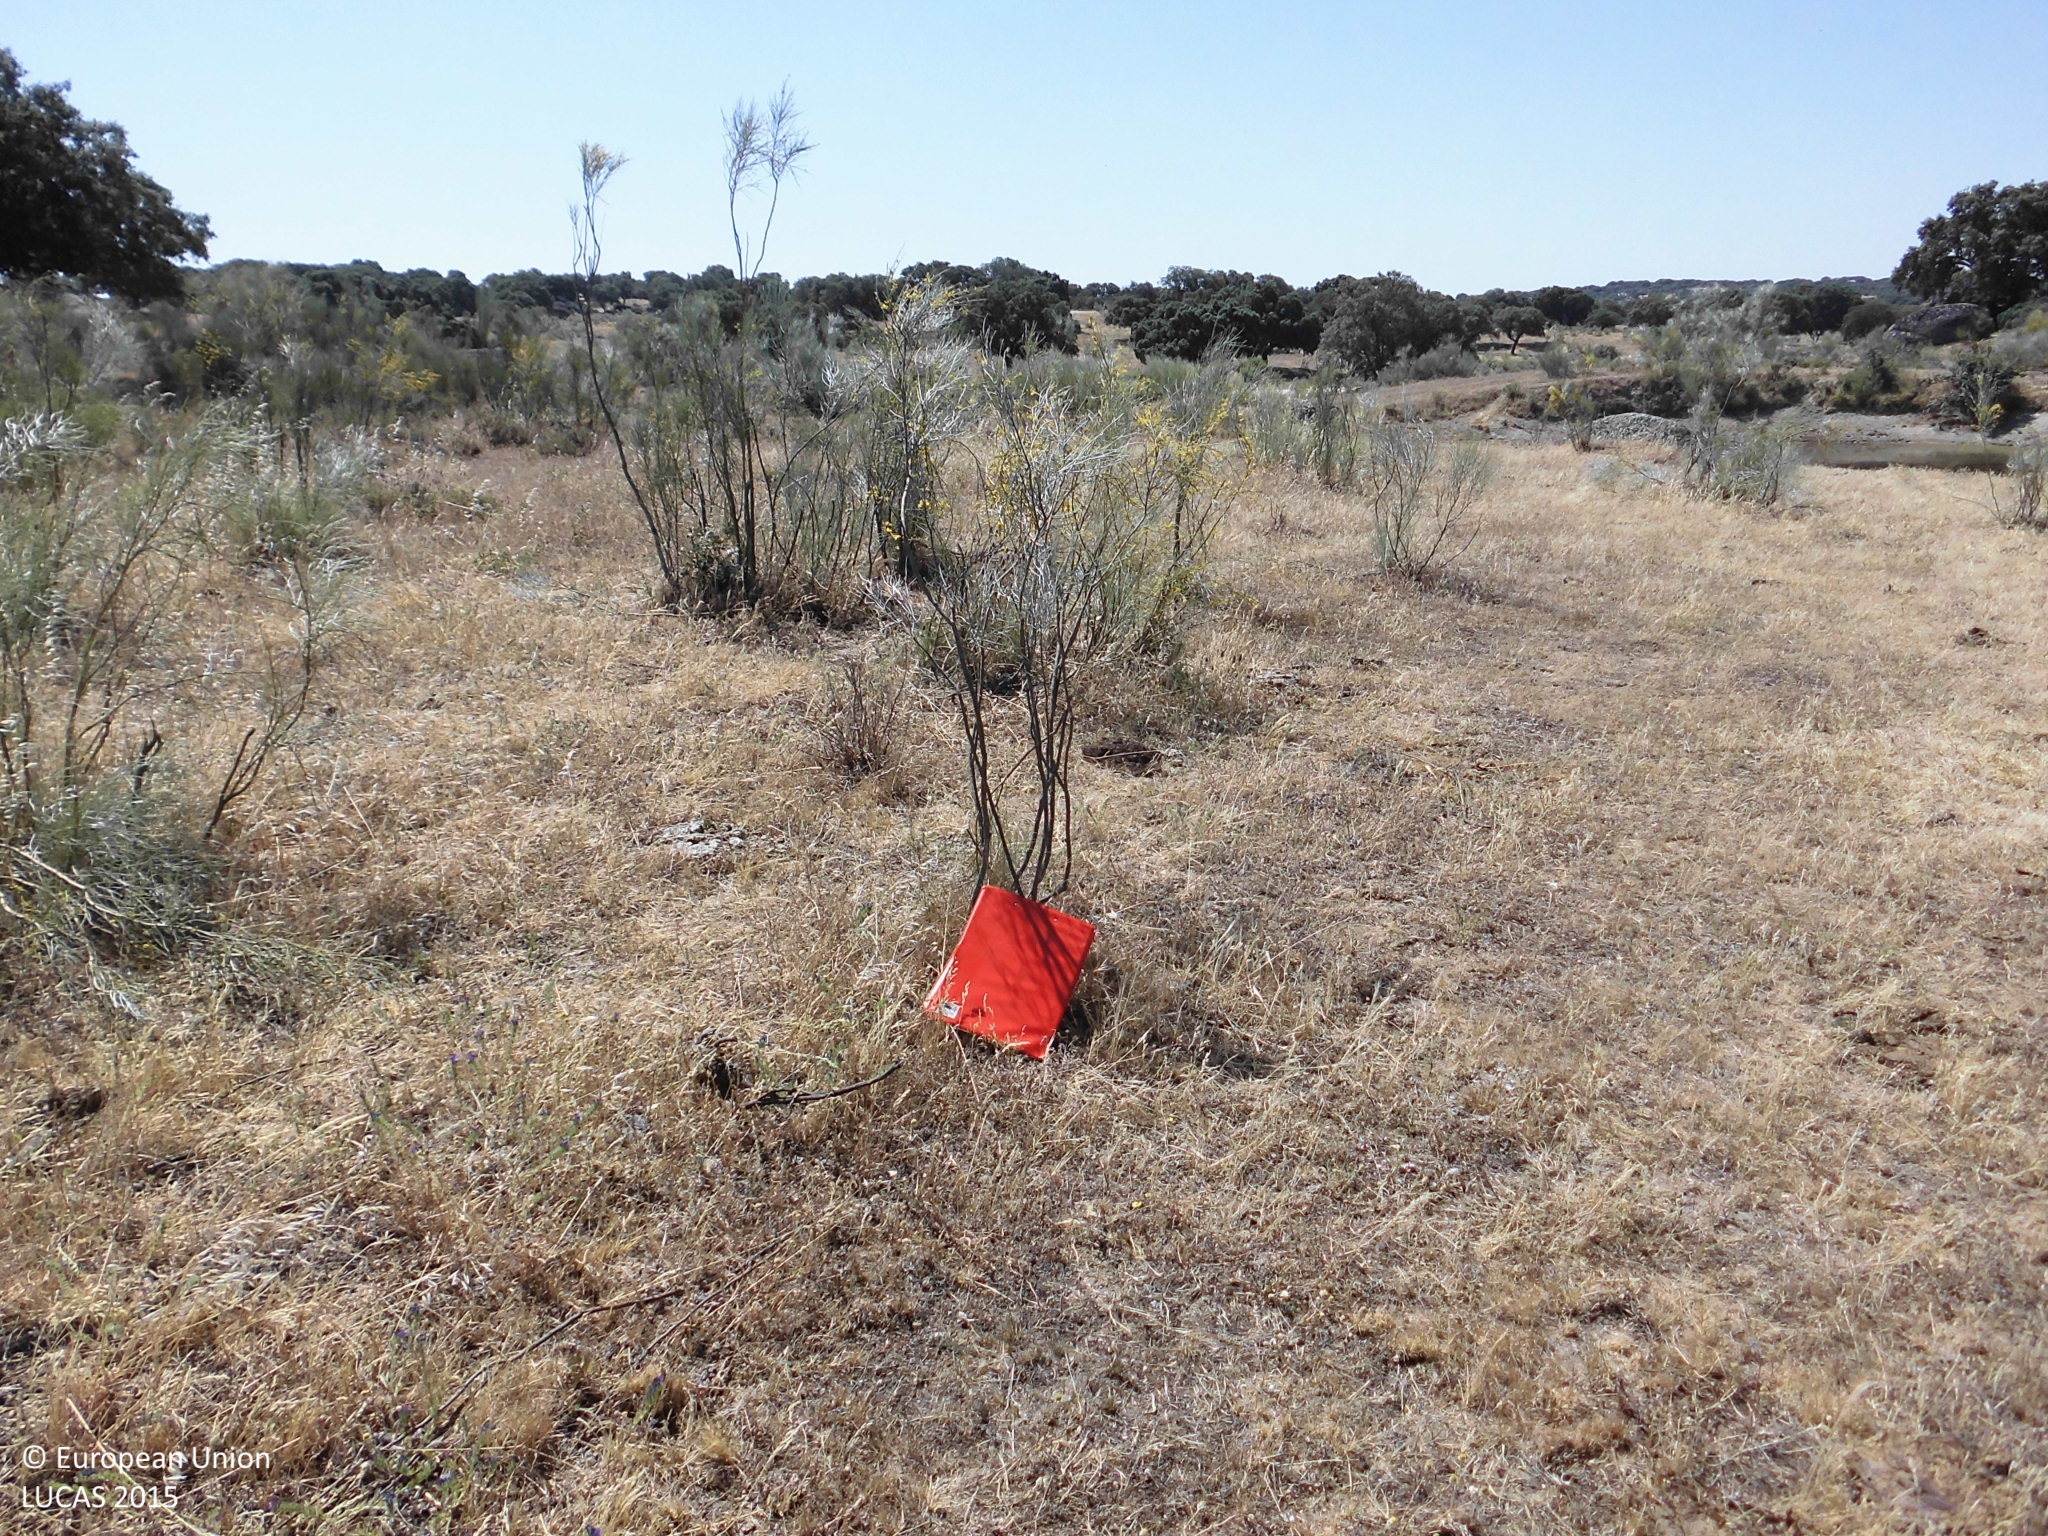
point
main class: Woodland
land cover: Broadleaved woodland
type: broadleaved evergreen forest
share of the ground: 10 - 25 %
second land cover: Grassland without tree/shrub cover
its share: > 75 %
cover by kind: herbaceous plants 85 %, broadleaved forest trees 15 %
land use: Forestry
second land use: Agriculture (excluding fallow land and kitchen gardens)
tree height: > 5 m
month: May
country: ES
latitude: 39.6876
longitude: -6.7181
